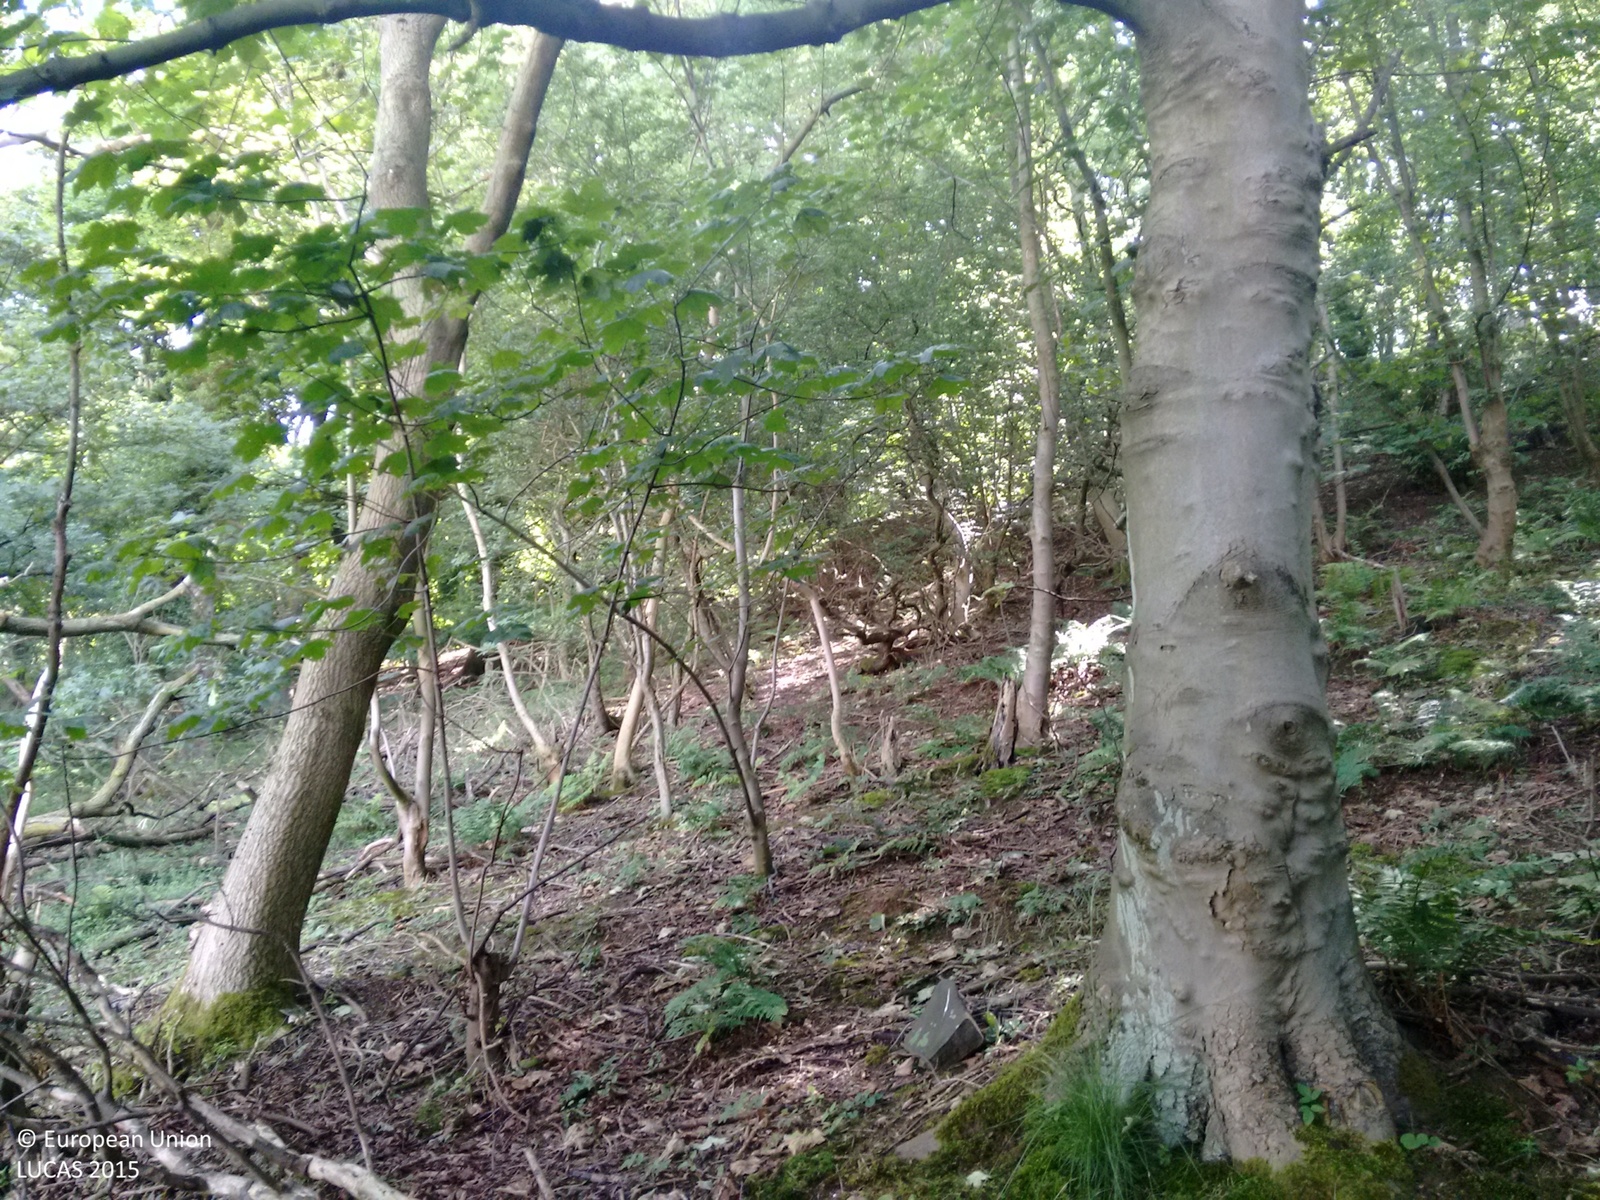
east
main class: Woodland
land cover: Broadleaved woodland
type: mesophytic deciduous forest
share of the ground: > 75 %
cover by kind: broadleaved forest trees 100 %
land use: Amenities, museums, leisure
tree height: > 5 m
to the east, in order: Broadleaved woodland; Dry stone walls; Tracks; Broadleaved woodland; Artificial constructions in urban areas
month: July
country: GB
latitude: 56.0307
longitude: -3.3780
